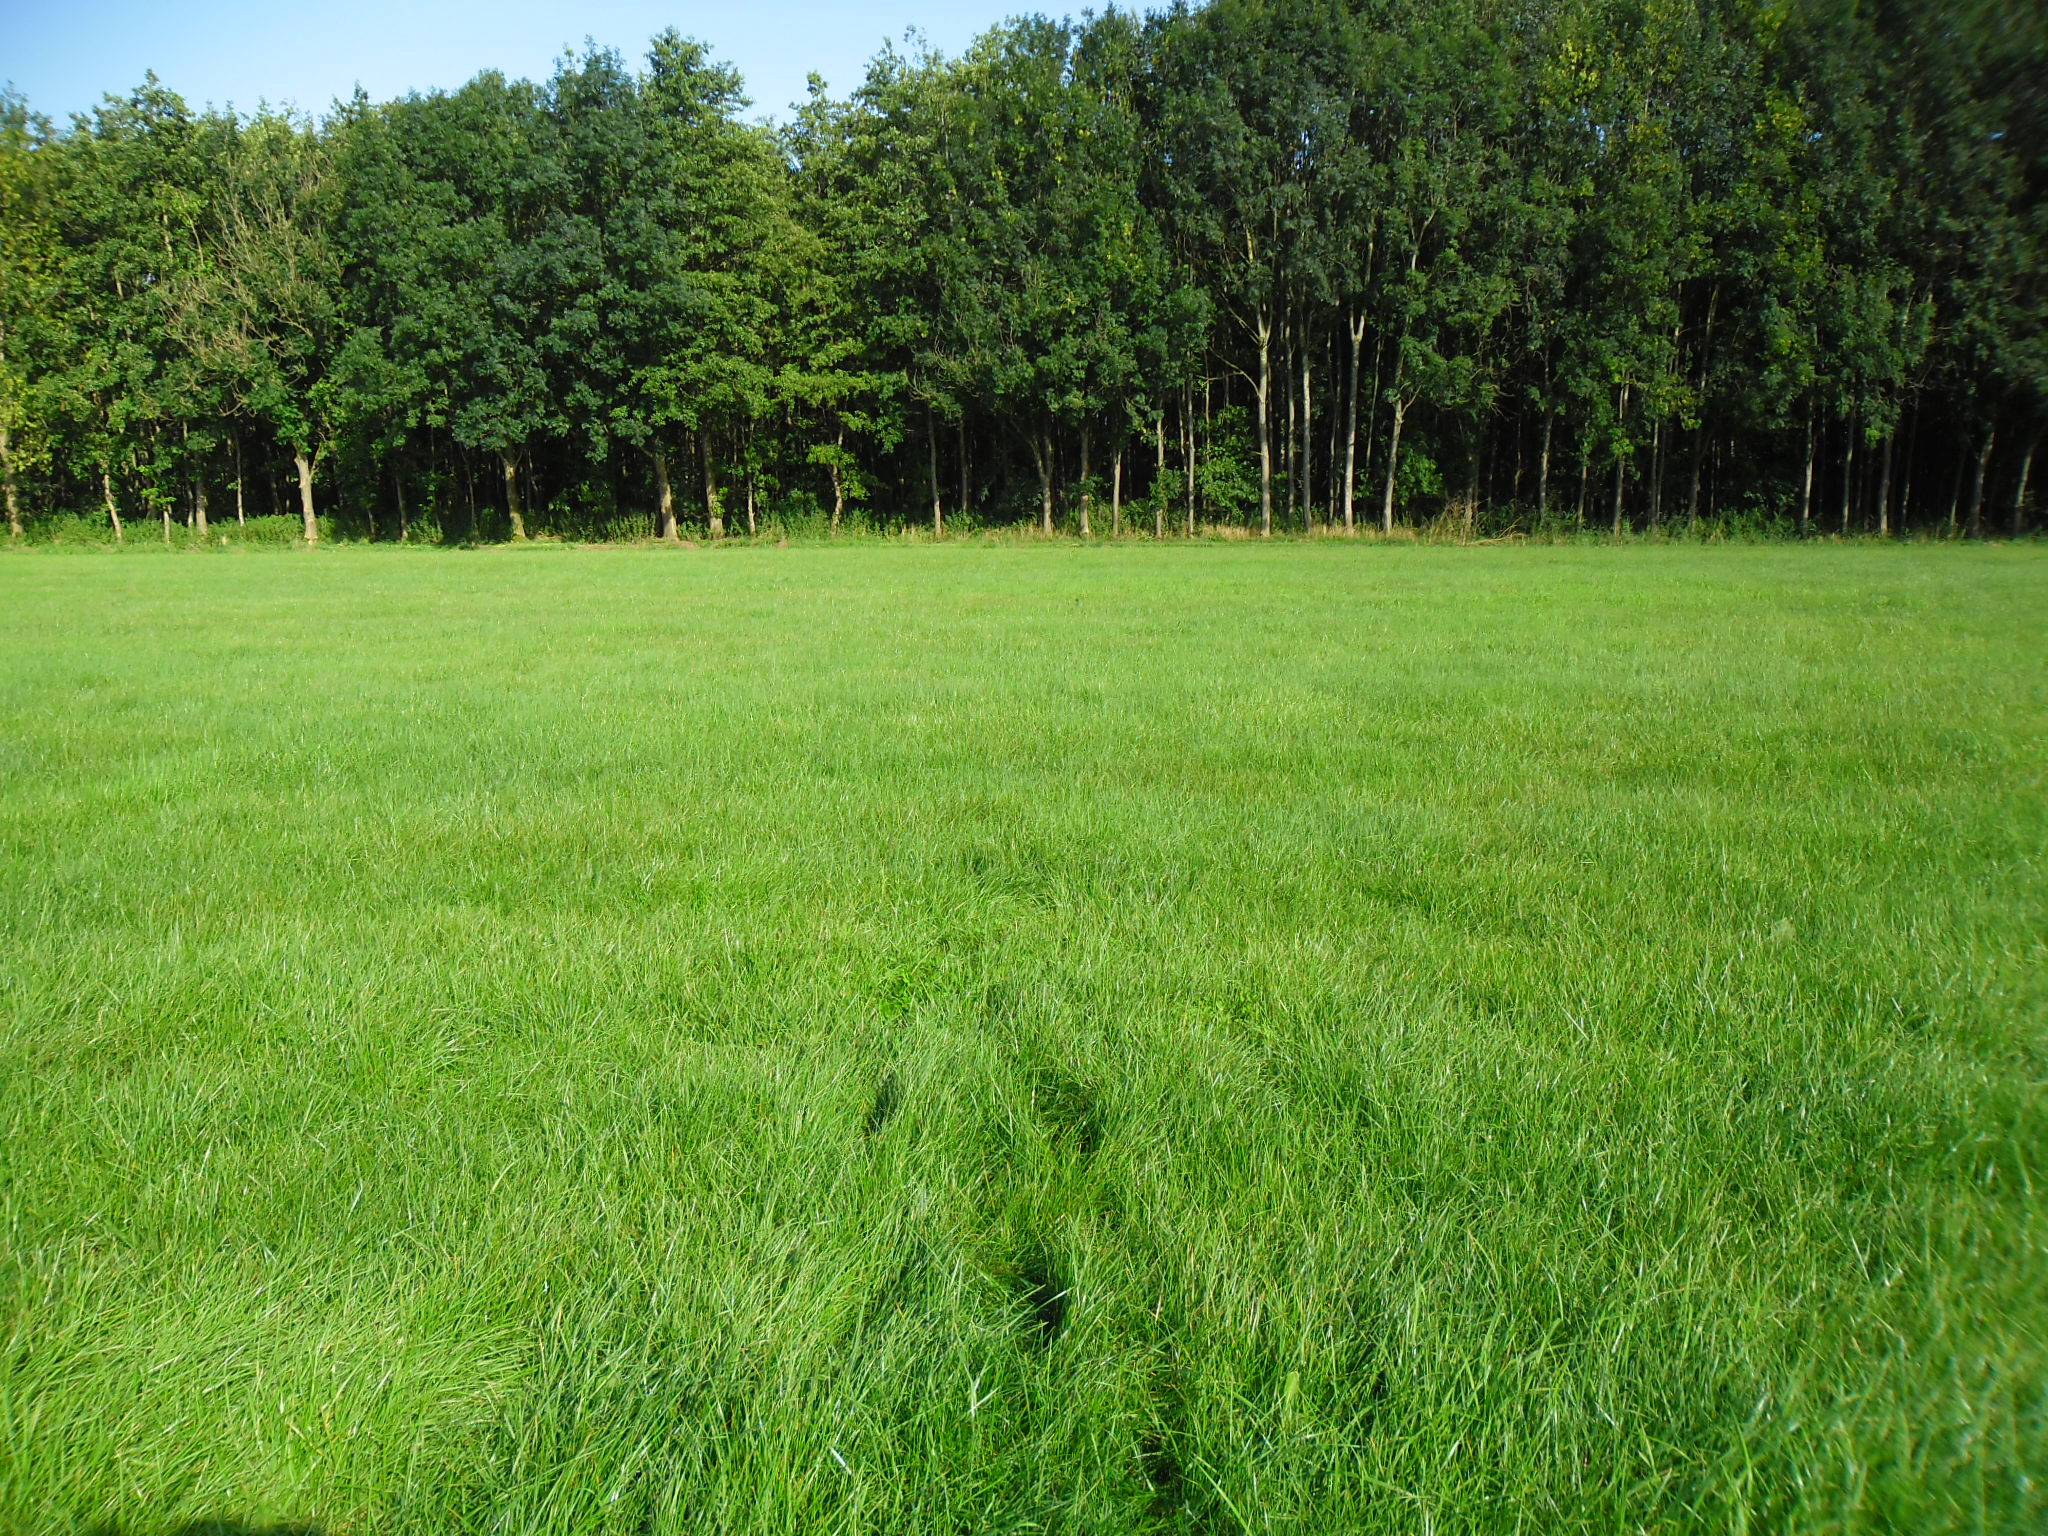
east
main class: Grassland
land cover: Grassland without tree/shrub cover
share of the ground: > 75 %
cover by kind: herbaceous plants 100 %
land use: Agriculture (excluding fallow land and kitchen gardens)
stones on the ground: < 10 %
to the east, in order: Grassland without tree/shrub cover; Inland fresh running water; Grass margins; Broadleaved woodland; Inland fresh running water; Lines of trees; Maize; Spontaneously vegetated surfaces; Paved roads, cycling and walking lanes; Spontaneously vegetated surfaces; Paved roads, cycling and walking lanes
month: September
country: NL
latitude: 52.0834
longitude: 6.2198
